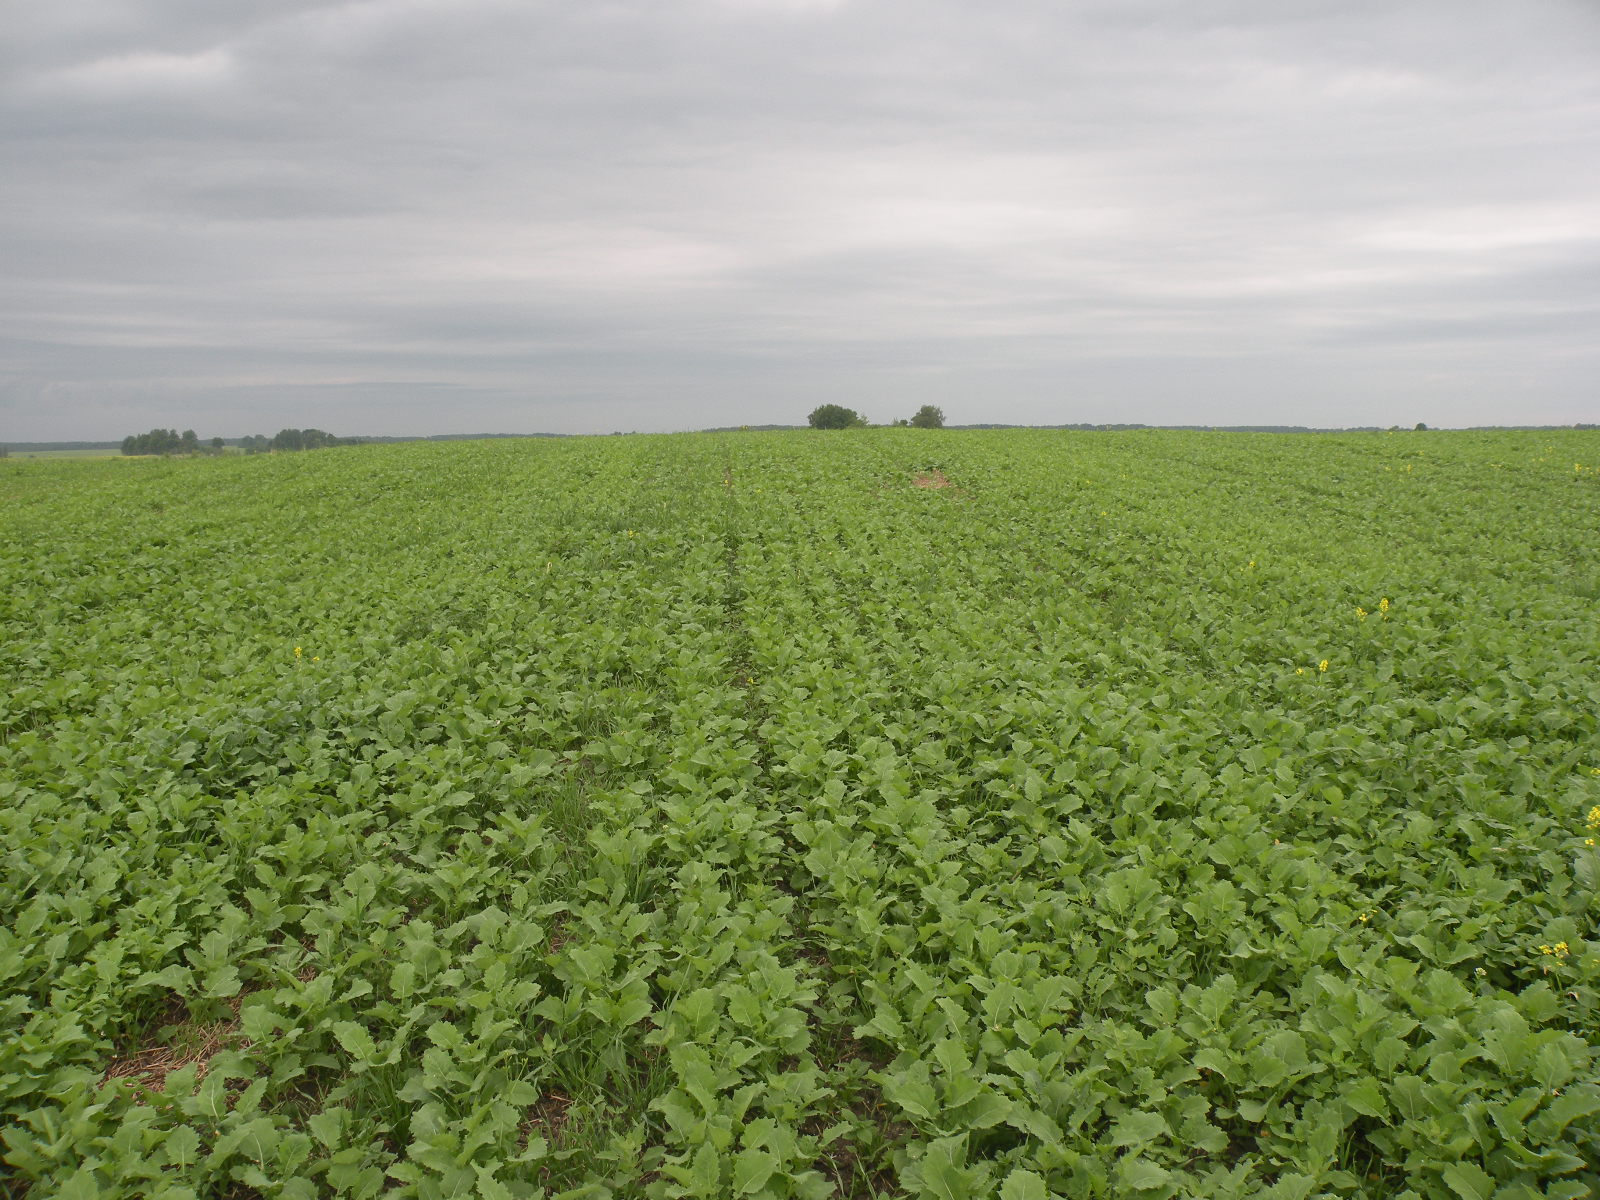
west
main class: Cropland
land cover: Rape and turnip rape
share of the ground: > 75 %
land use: Agriculture (excluding fallow land and kitchen gardens)
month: June
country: LV
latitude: 56.0084
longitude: 26.7905
